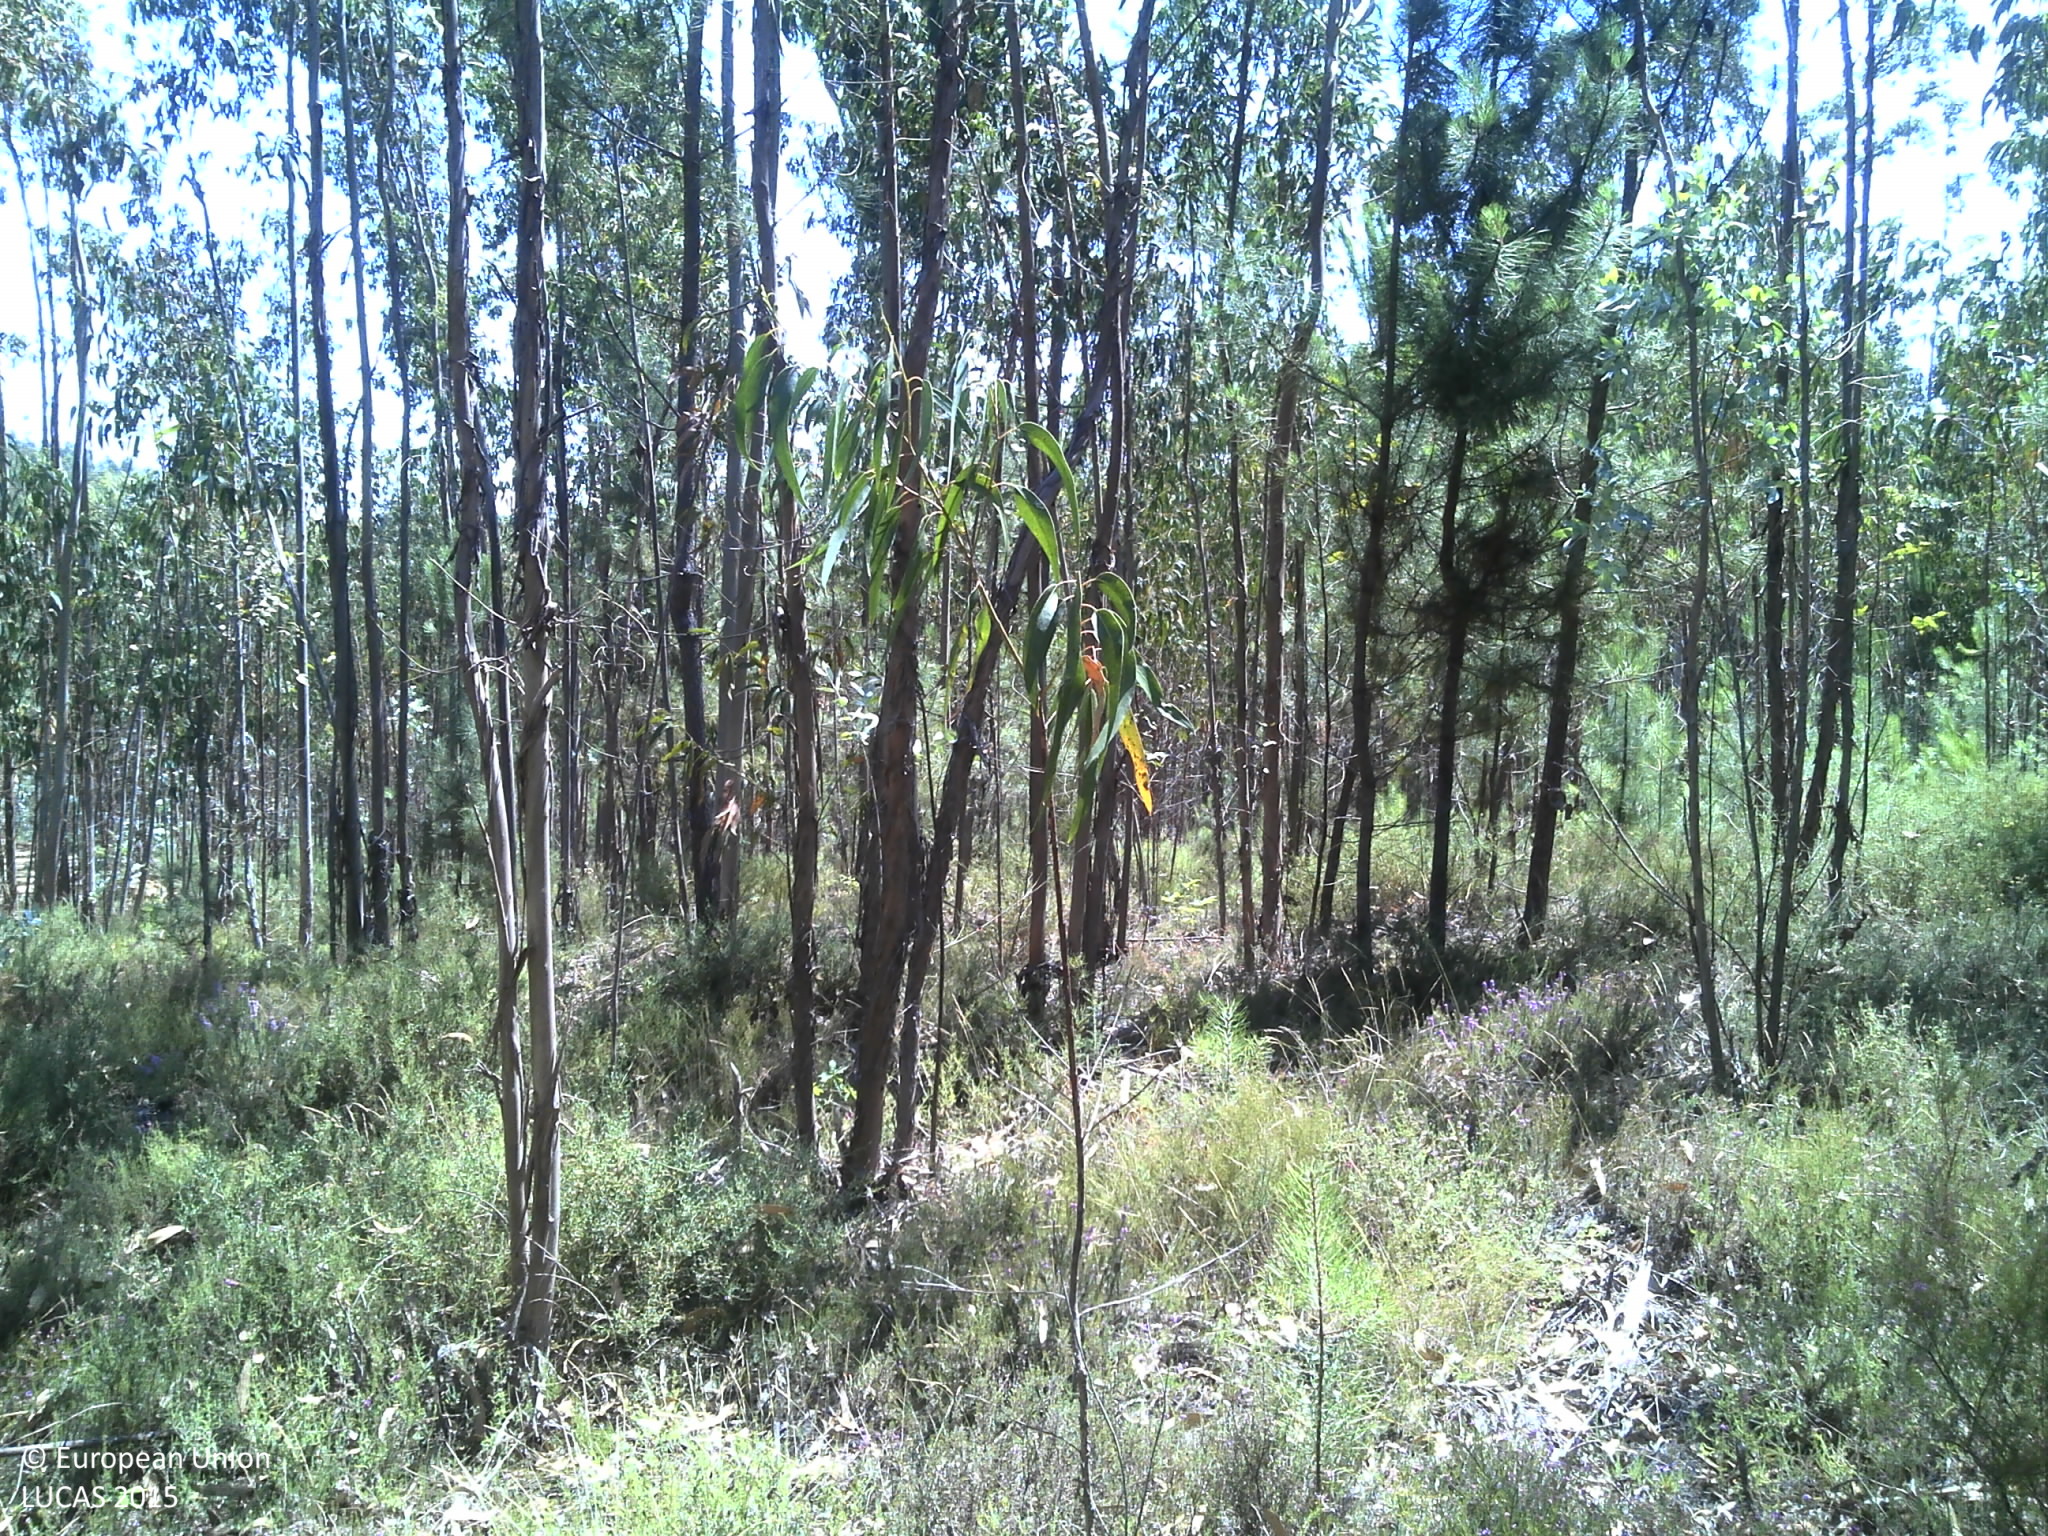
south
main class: Woodland
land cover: Broadleaved woodland
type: exotic forest
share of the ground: 25 - 50 %
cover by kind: broadleaved forest trees 50 %, shrubs 25 %, unconsolidated bare surface 20 %, coniferous forest trees 5 %
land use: Forestry
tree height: > 5 m
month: July
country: PT
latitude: 40.4344
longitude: -8.1997
